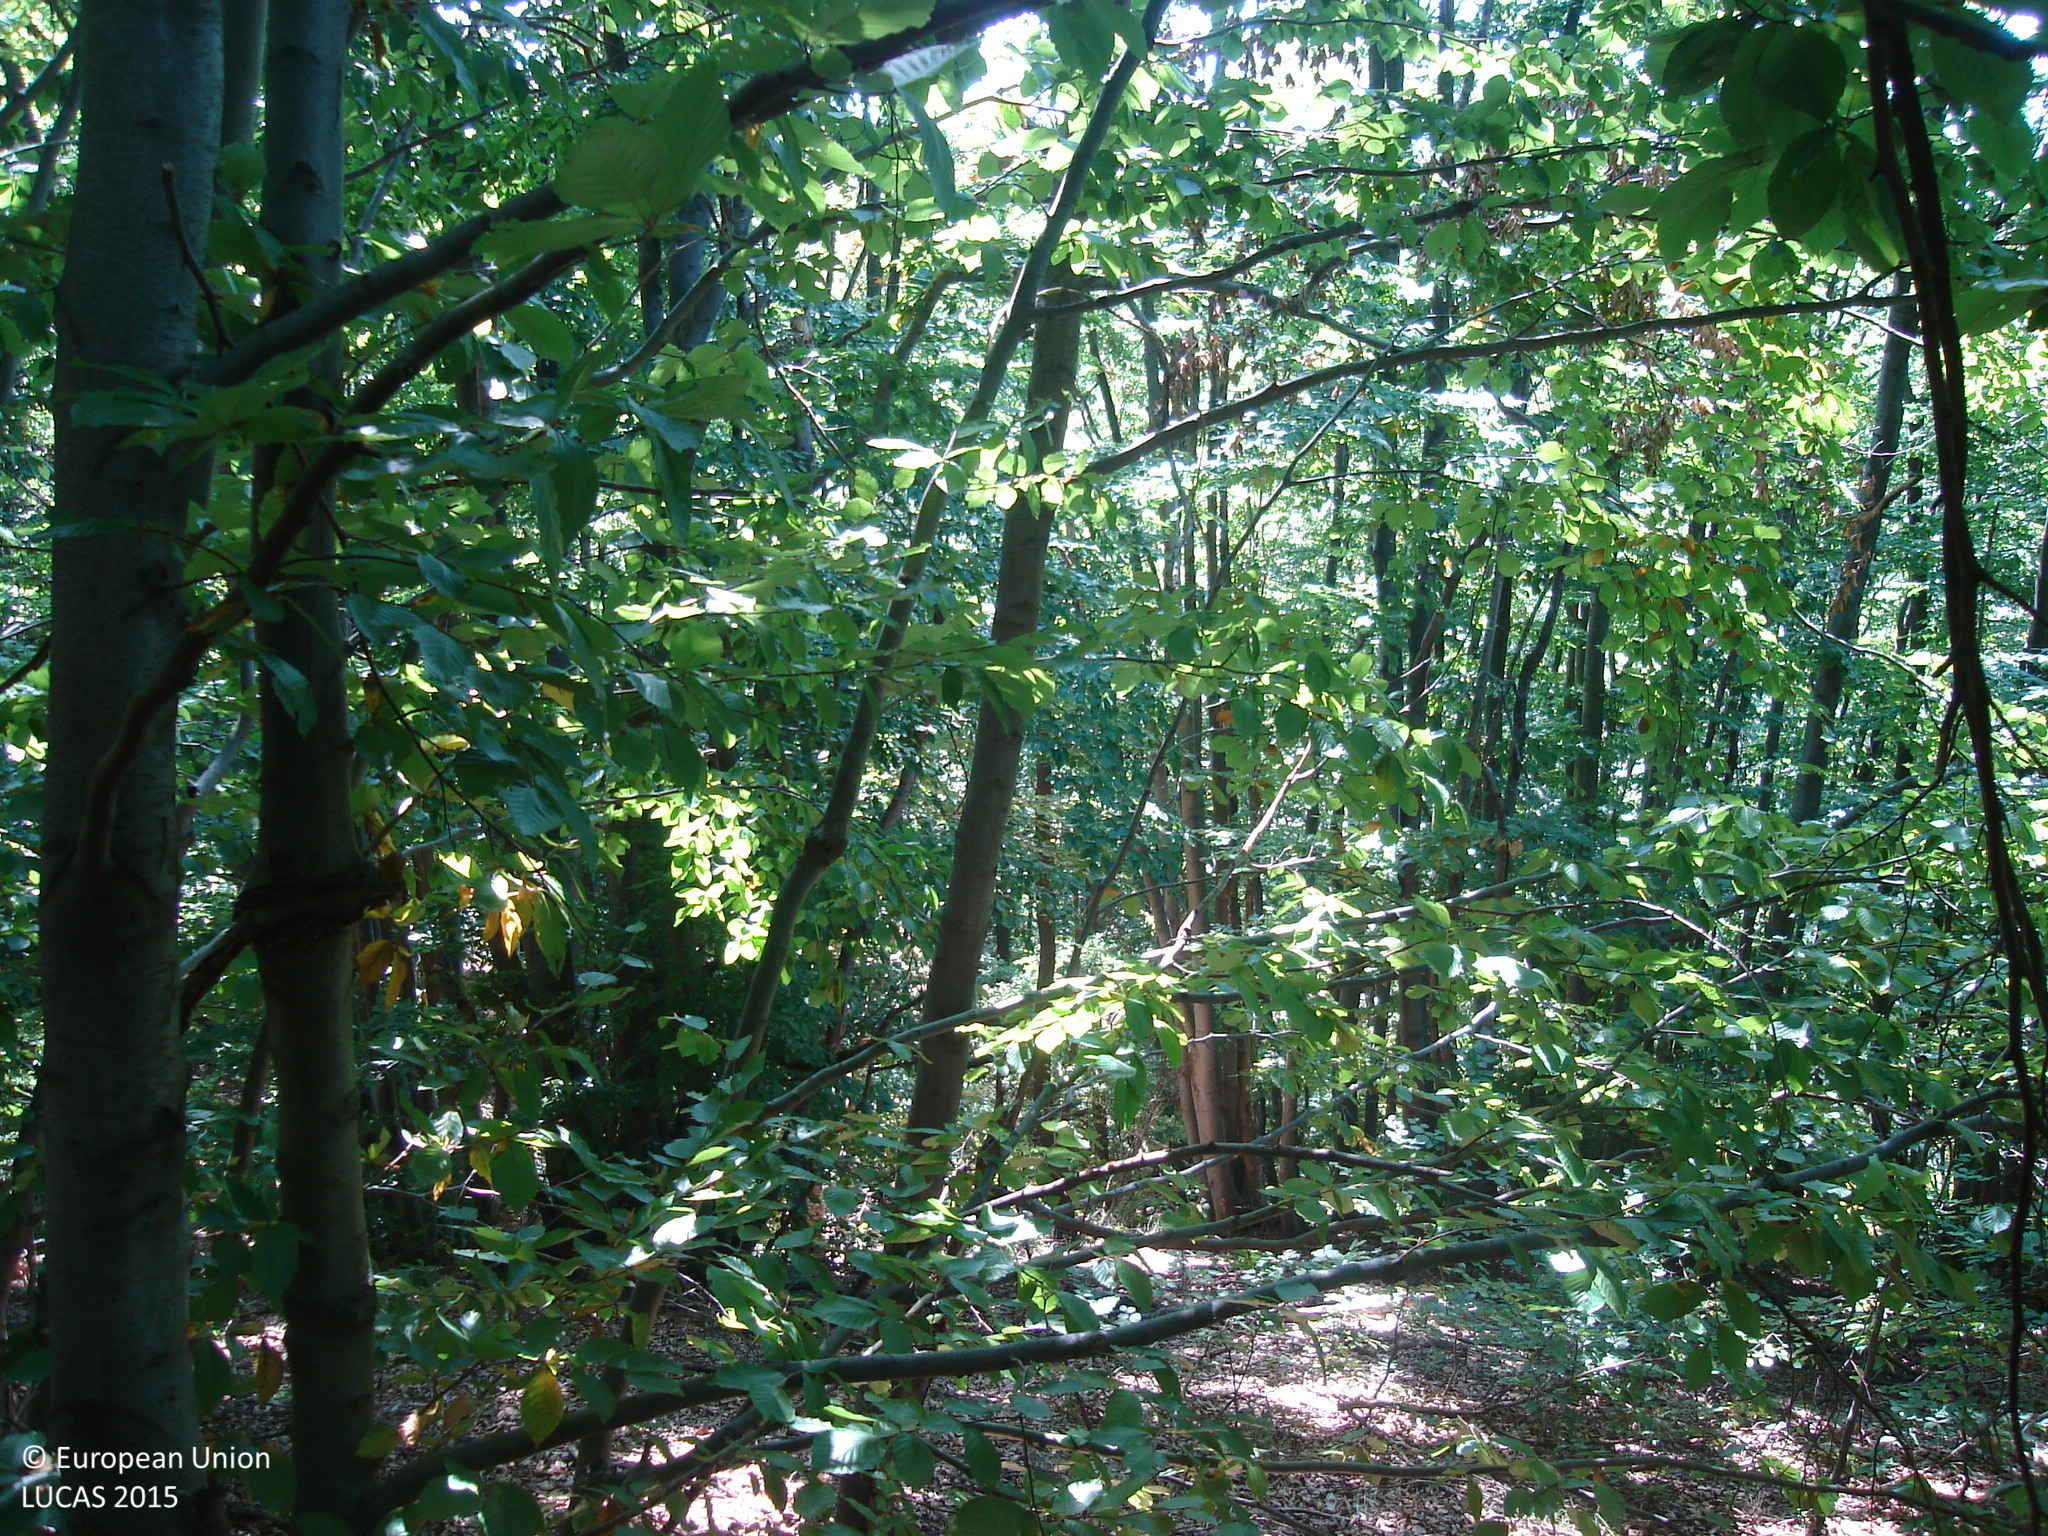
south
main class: Woodland
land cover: Broadleaved woodland
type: beech forest
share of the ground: > 75 %
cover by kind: broadleaved forest trees 100 %
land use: Forestry
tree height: > 5 m
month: September
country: BG
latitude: 42.5264
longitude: 23.8082
